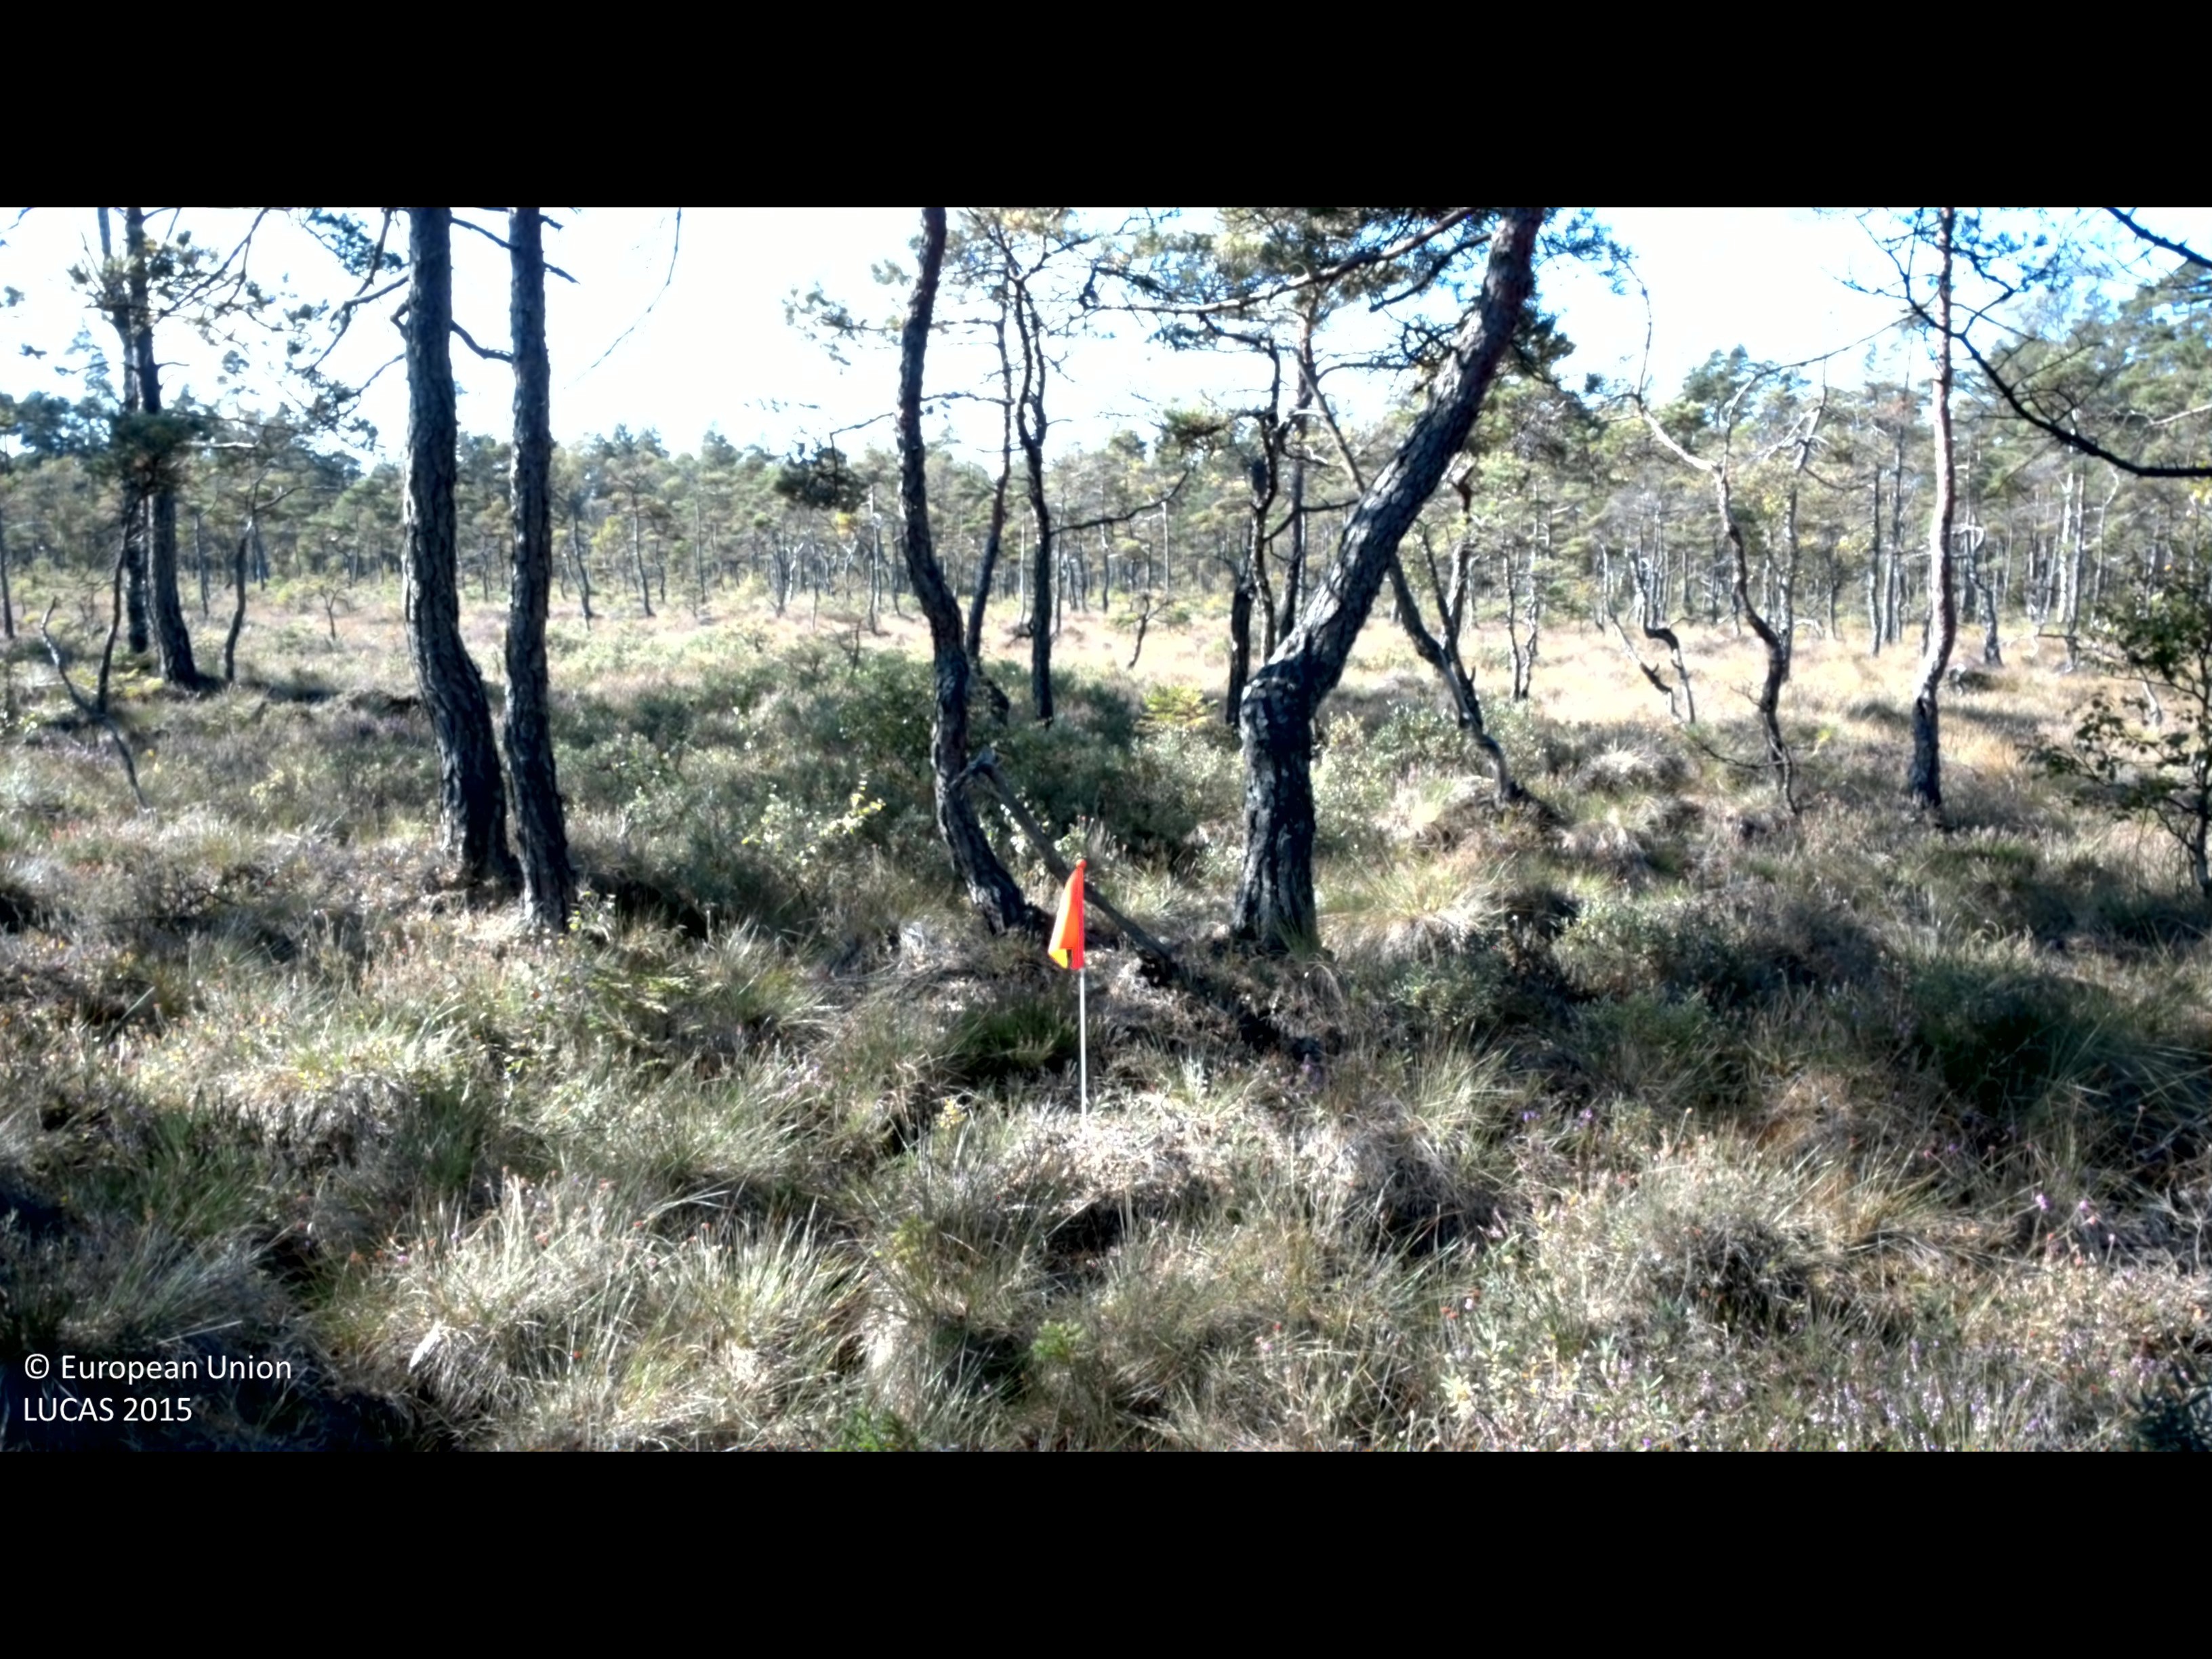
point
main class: Woodland
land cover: Pine dominated coniferous woodland
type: mire and swamp forests
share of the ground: 50 - 75 %
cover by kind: coniferous forest trees 65 %, shrubs 20 %, herbaceous plants 10 %, broadleaved forest trees 5 %
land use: Semi-natural and natural areas not in use
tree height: > 5 m
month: September
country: SE
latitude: 57.0661
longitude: 13.1792
